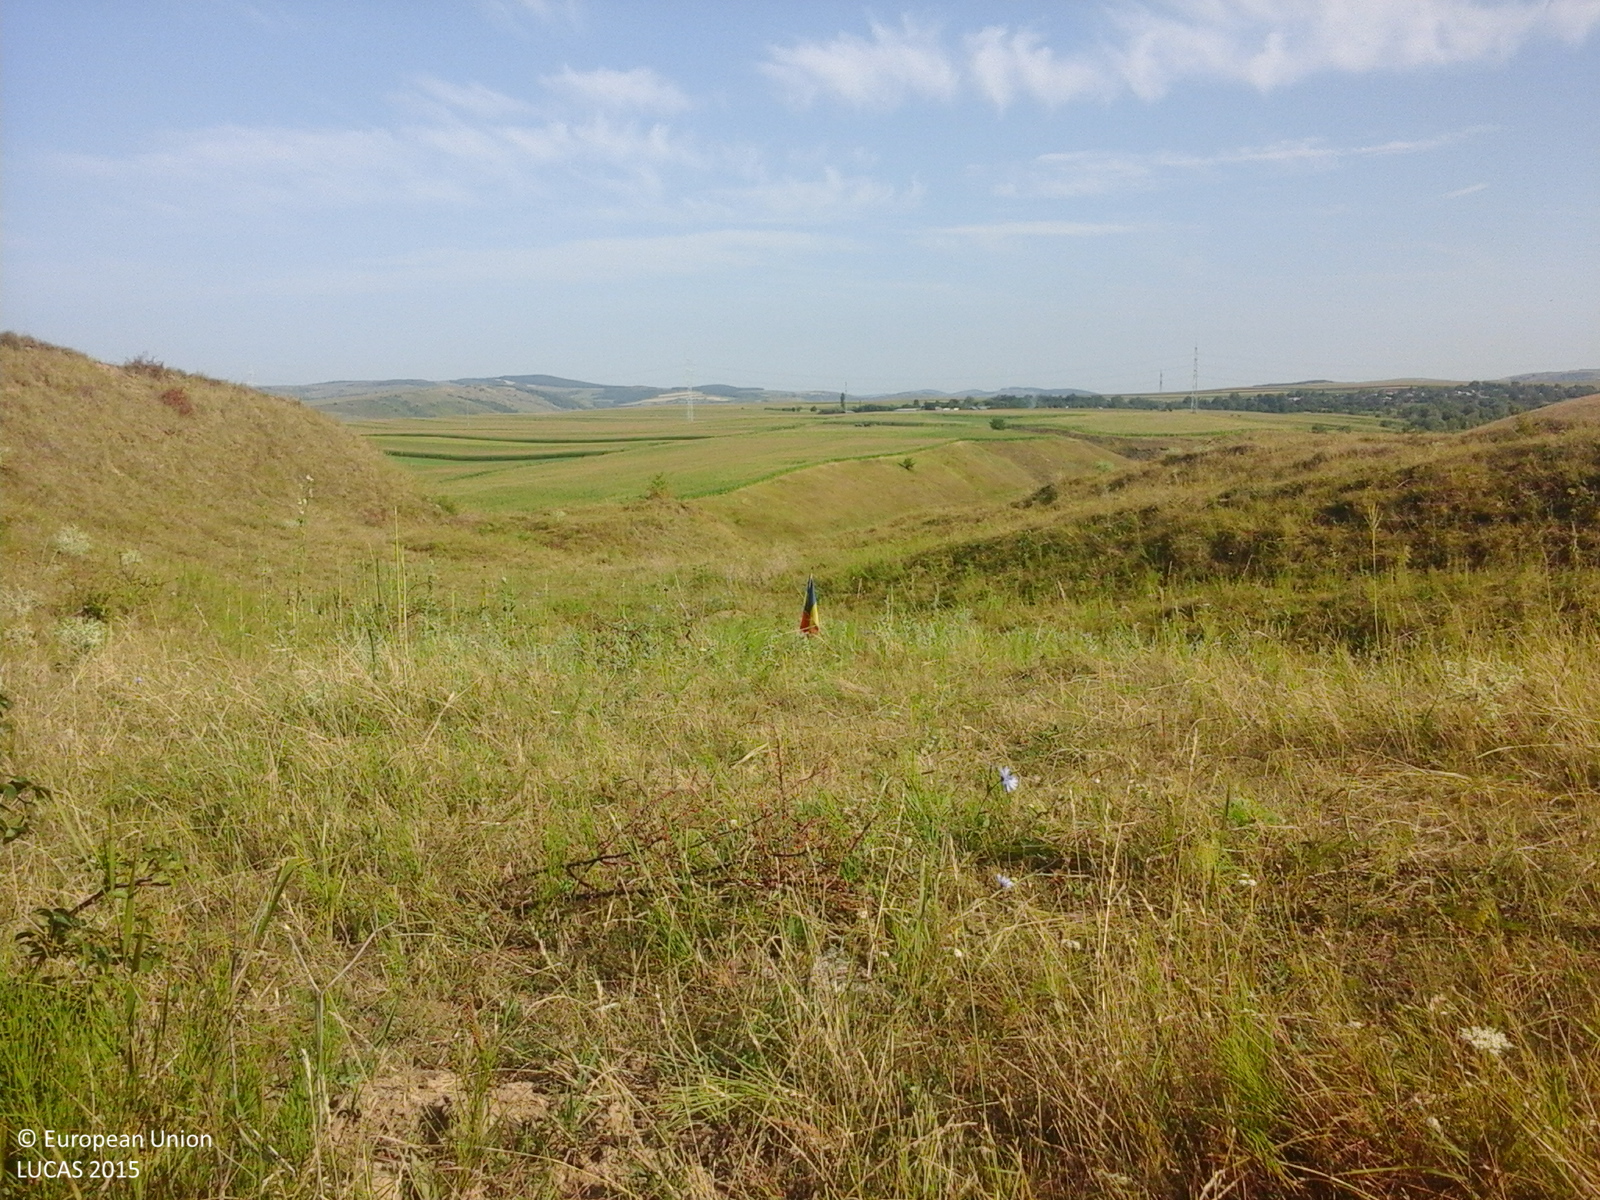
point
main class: Grassland
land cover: Grassland without tree/shrub cover
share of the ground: > 75 %
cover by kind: herbaceous plants 100 %
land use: Agriculture (excluding fallow land and kitchen gardens)
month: July
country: RO
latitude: 46.2111
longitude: 27.3295
